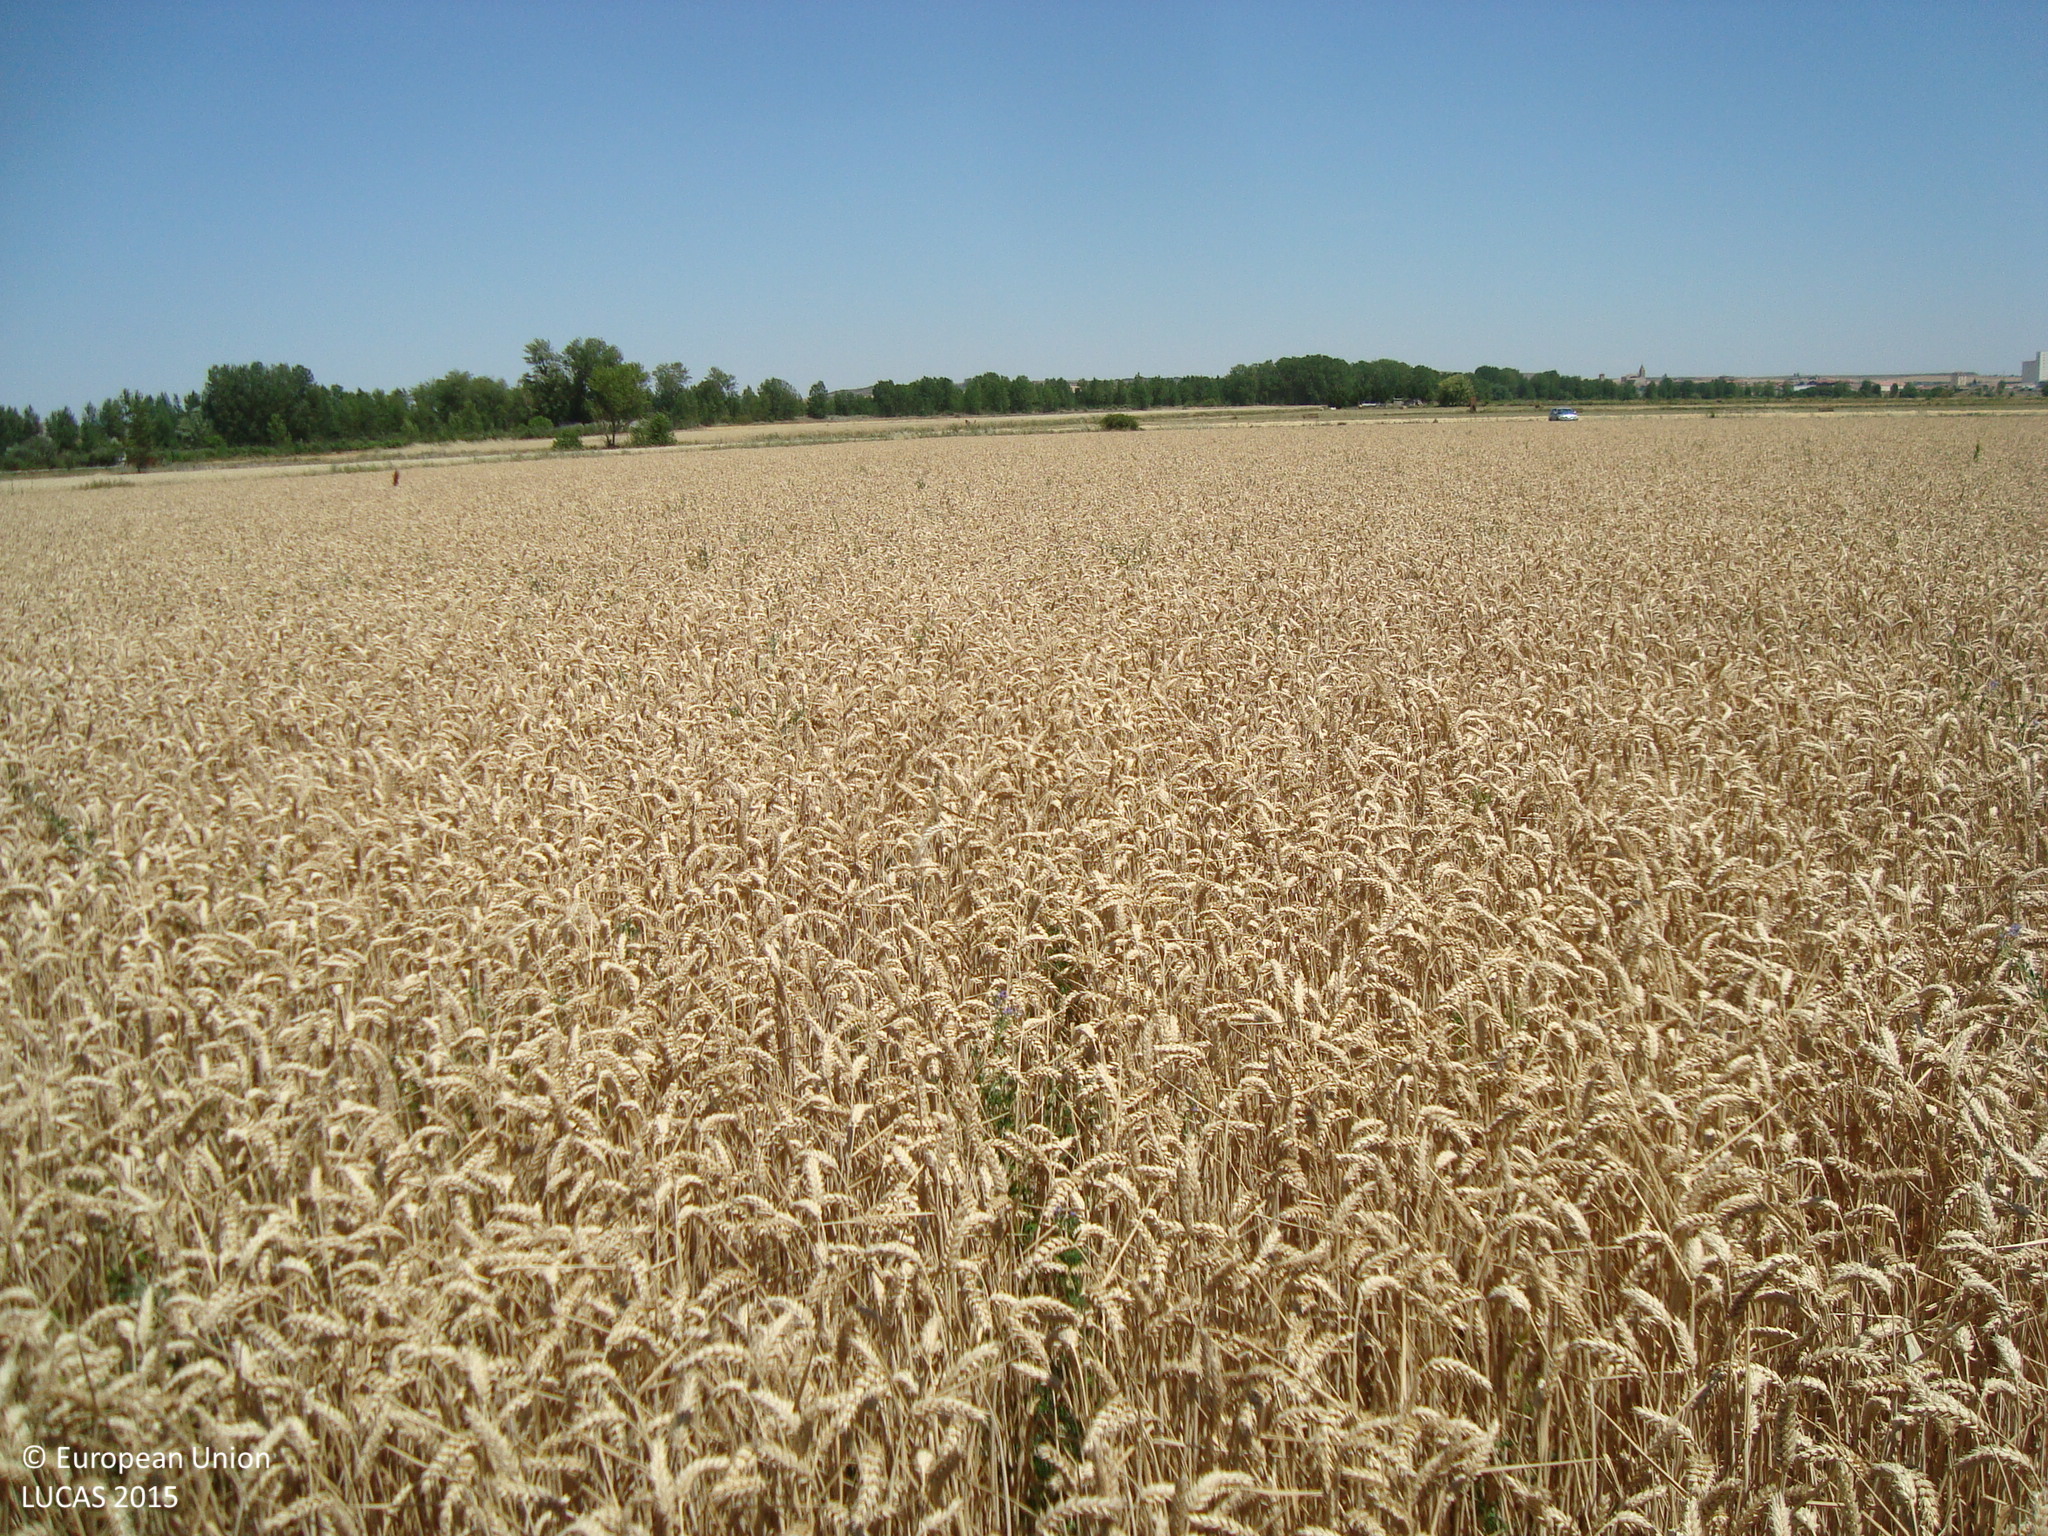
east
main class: Cropland
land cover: Common wheat
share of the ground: > 75 %
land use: Agriculture (excluding fallow land and kitchen gardens)
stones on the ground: < 10 %
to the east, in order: Common wheat; Grass margins; Rivers and streams; Grass margins; Tracks; Barley
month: July
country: ES
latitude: 42.1566
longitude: -4.7316
